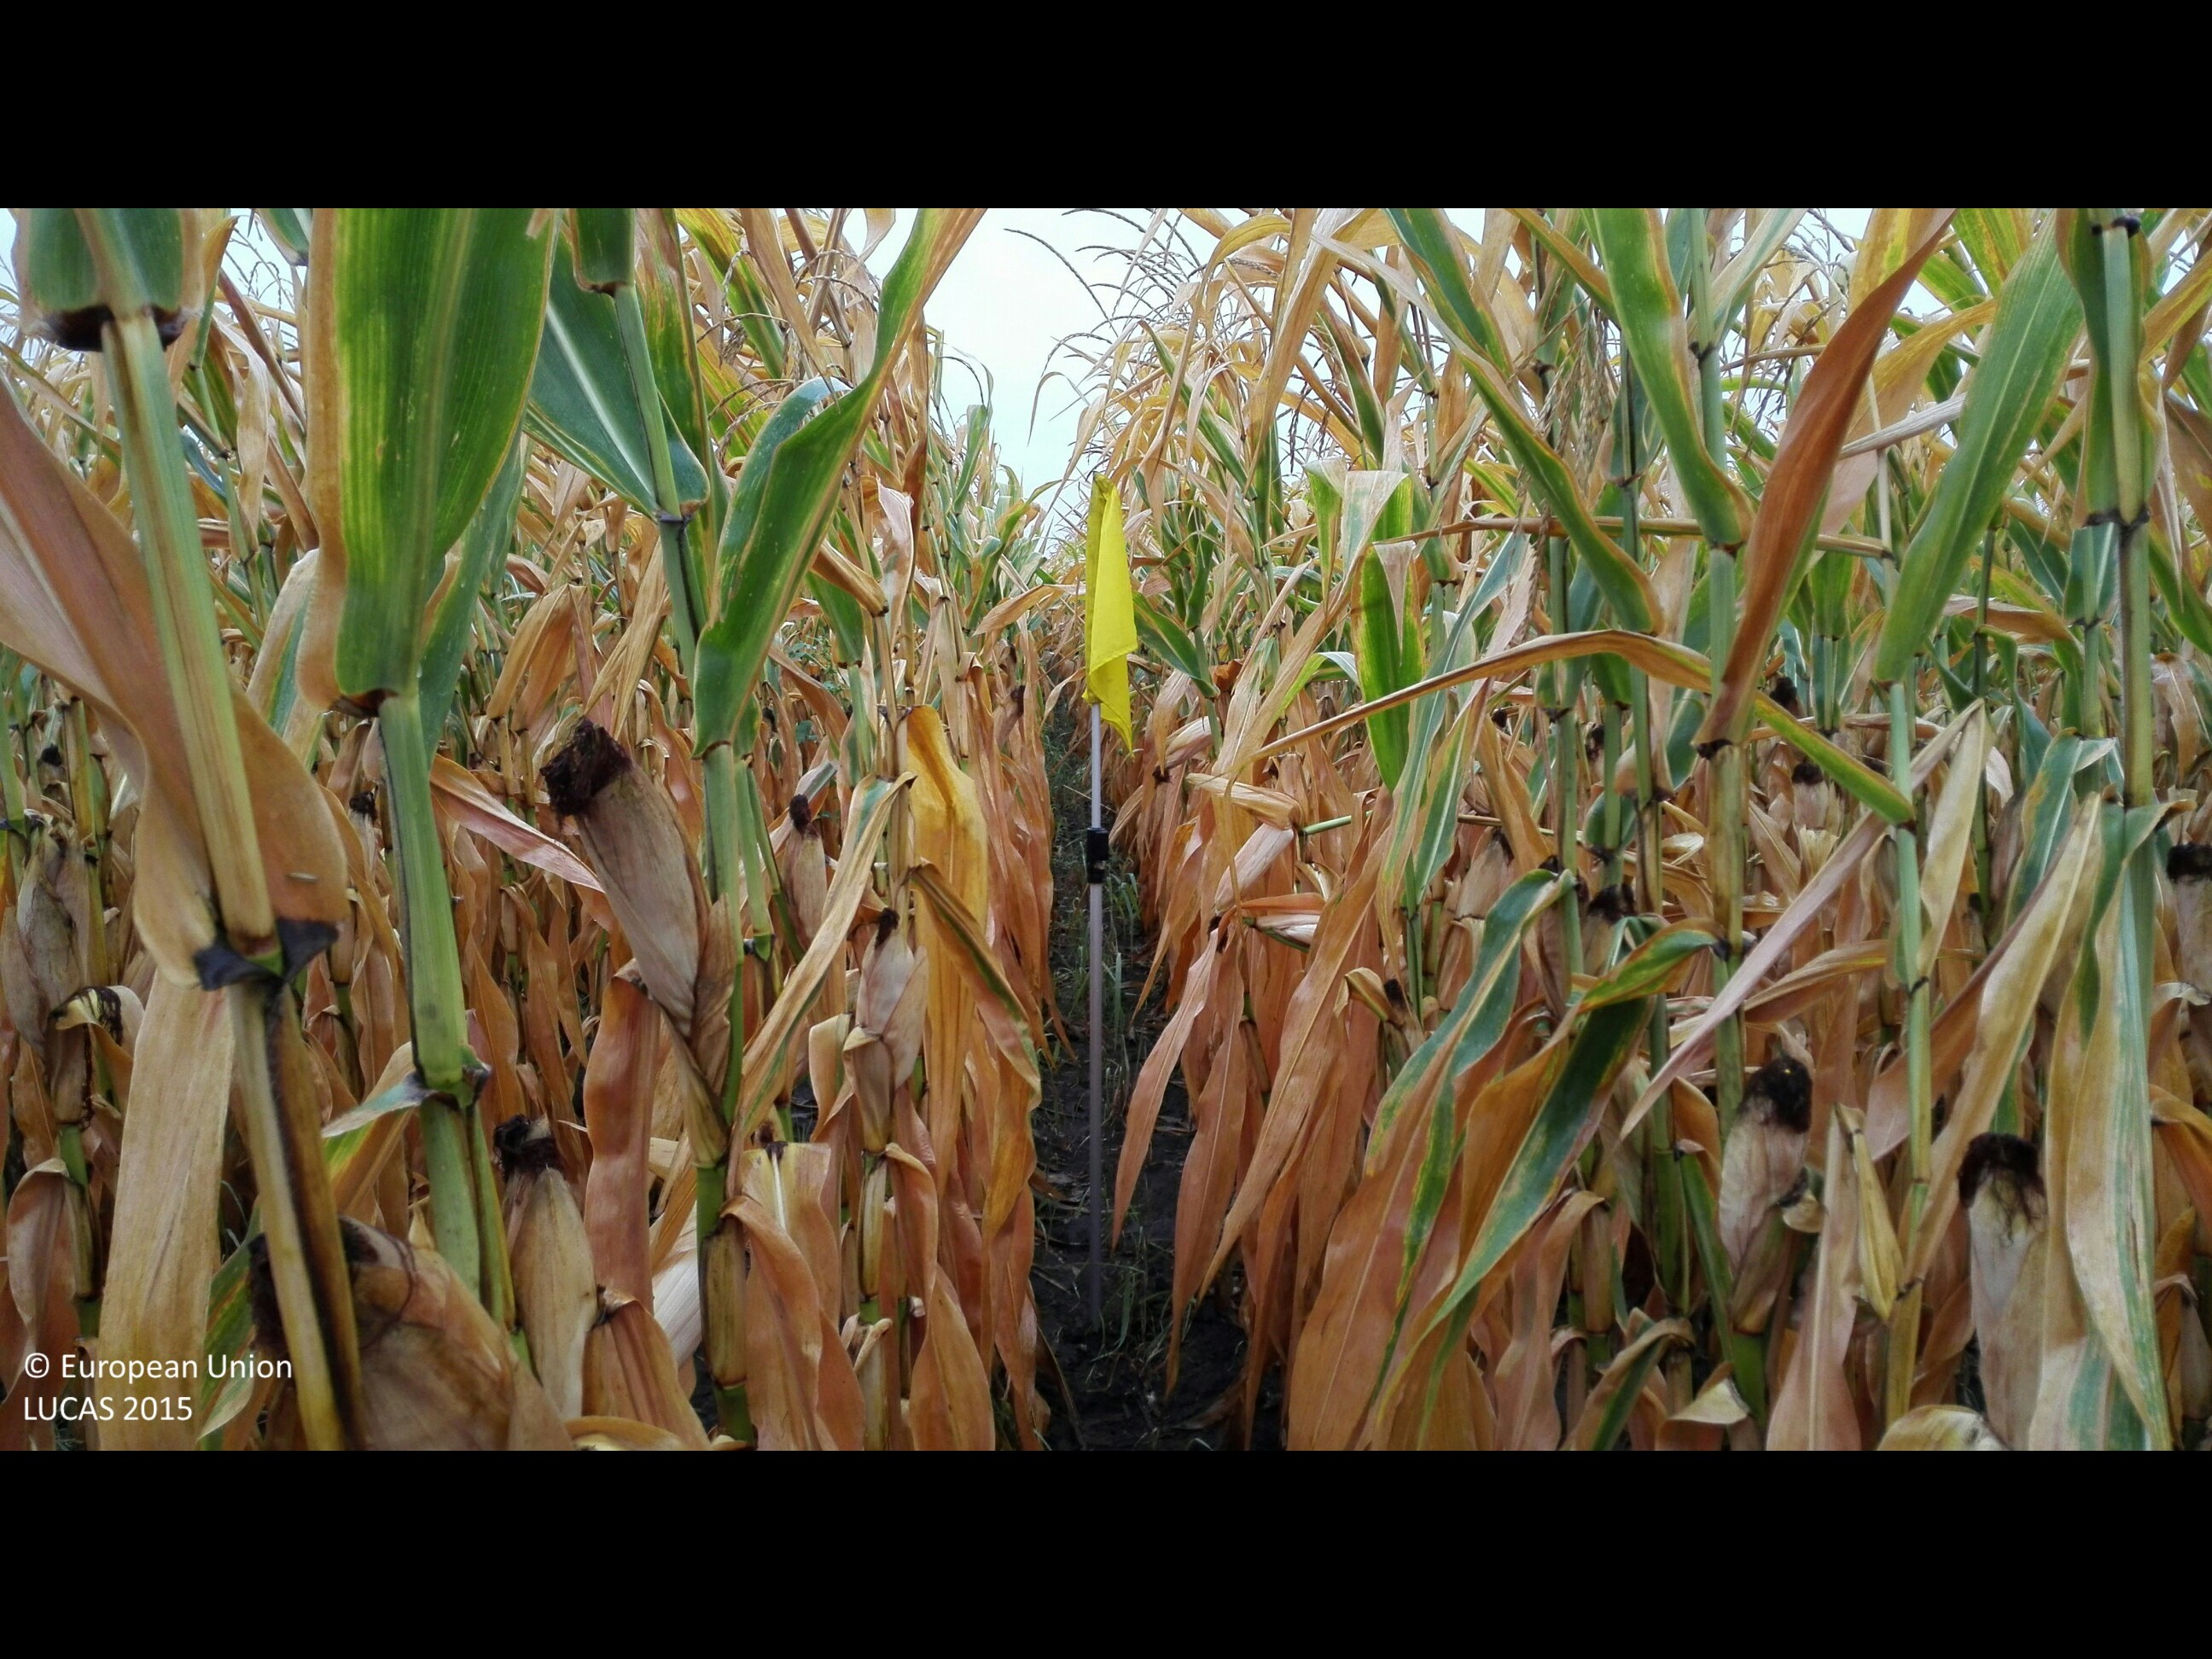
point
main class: Cropland
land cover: Maize
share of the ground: > 75 %
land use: Agriculture (excluding fallow land and kitchen gardens)
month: August
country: HU
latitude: 47.2478
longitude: 21.5769
